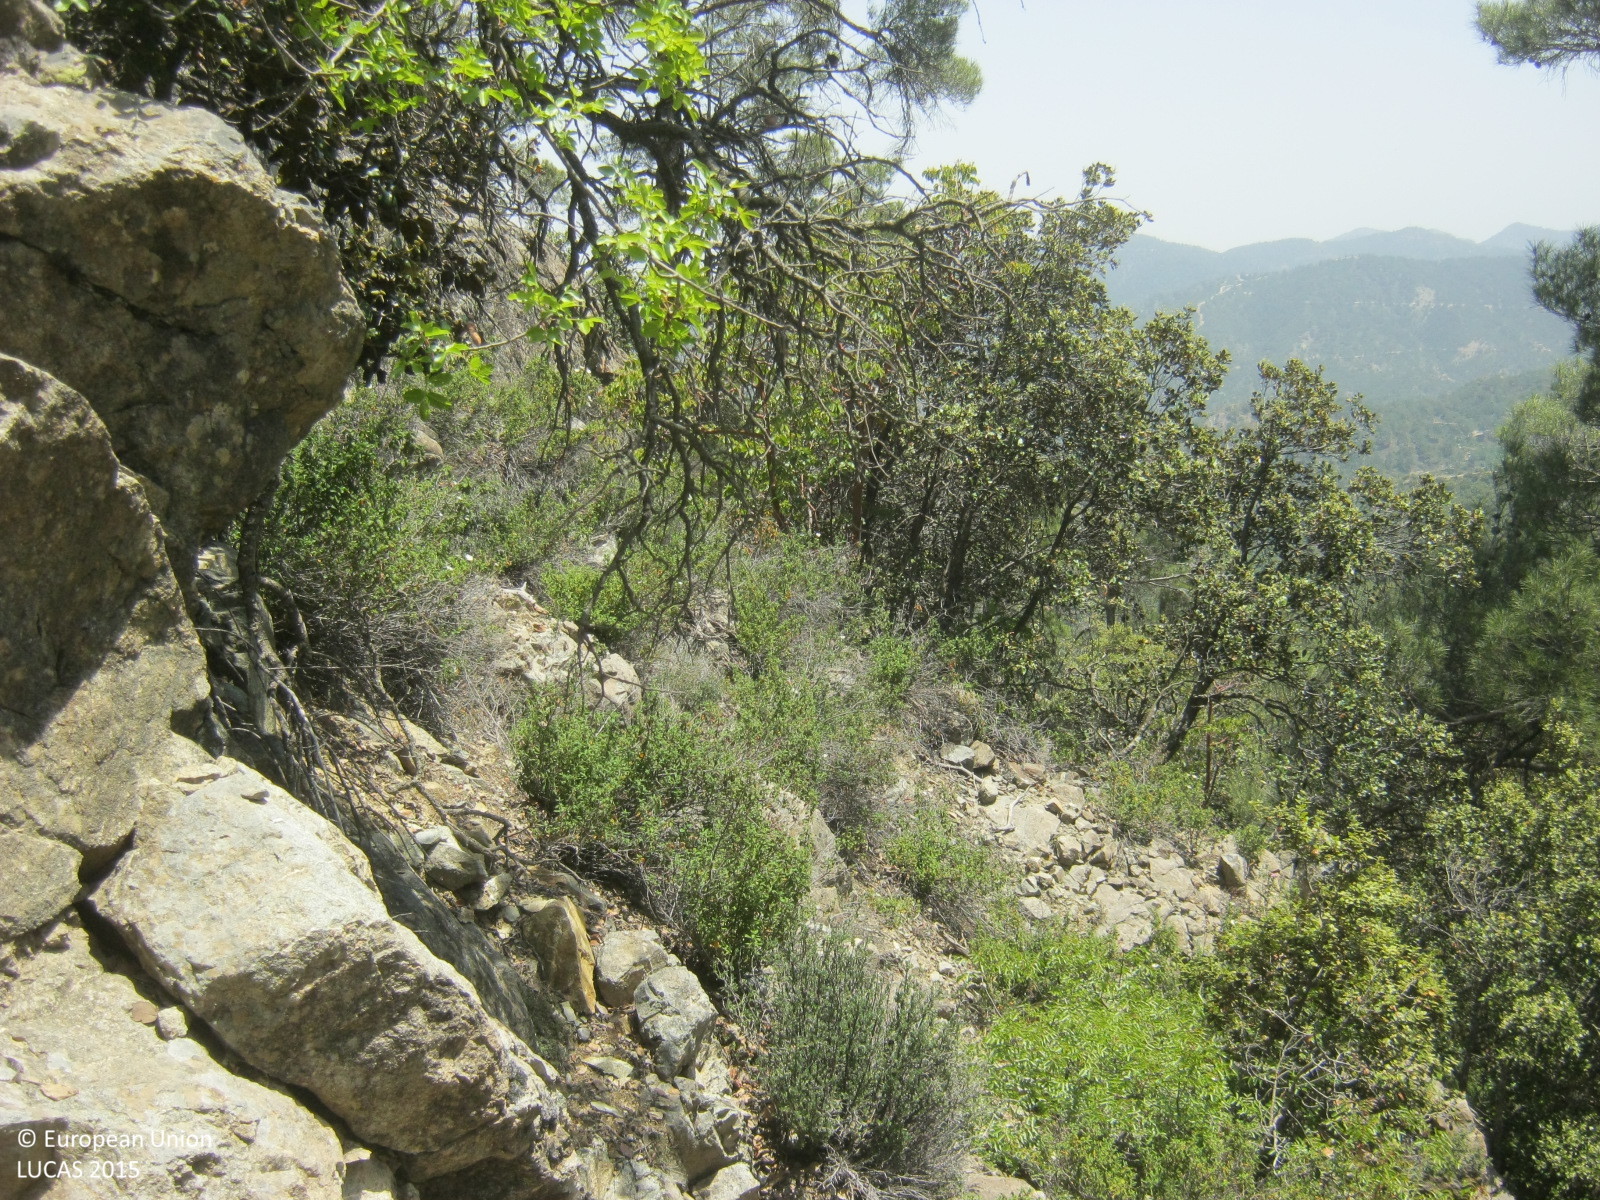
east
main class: Woodland
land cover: Pine dominated mixed woodland
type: coniferous forest of the mediterranean region
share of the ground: 50 - 75 %
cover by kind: coniferous forest trees 50 %, broadleaved forest trees 25 %, shrubs 10 %, consolidated bare surface 10 %, unconsolidated bare surface 5 %
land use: Forestry
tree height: > 5 m
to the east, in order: Pine dominated mixed woodland; Rocks and stones; Pine dominated coniferous woodland; Paved roads, cycling and walking lanes; Pine dominated coniferous woodland; Rivers and streams; Pine dominated coniferous woodland
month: May
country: CY
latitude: 34.9759
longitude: 32.8749
